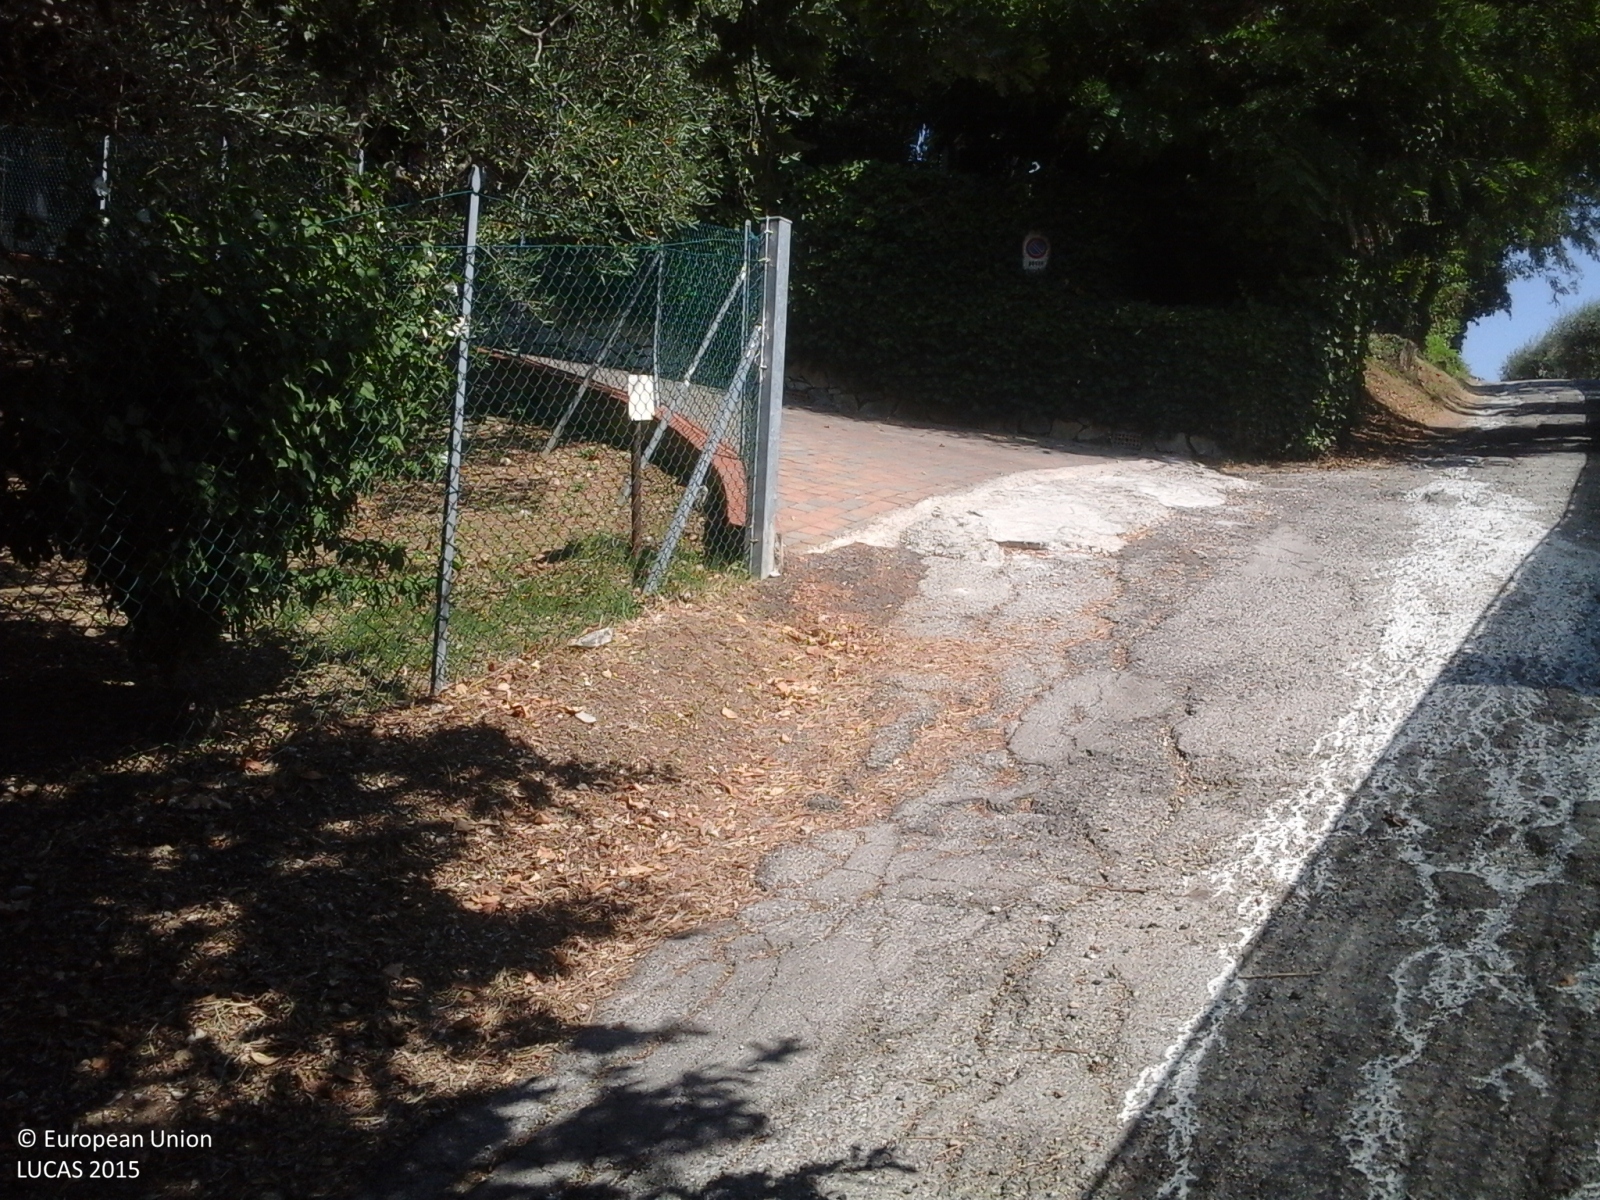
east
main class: Cropland
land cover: Olive groves
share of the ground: > 75 %
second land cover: Grassland without tree/shrub cover
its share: > 75 %
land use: Agriculture (excluding fallow land and kitchen gardens)
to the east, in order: Olive groves; Grassland without tree/shrub cover; Artificial constructions in urban areas; Olive groves; Electric lines; Olive groves; Artificial constructions in urban areas; Other fruit trees and berries; Common wheat; Electric lines; Common wheat; Electric lines; Grass margins; Ditches and canals; Grass margins; Paved roads, cycling and walking lanes; Common wheat; Artificial constructions in urban areas
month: July
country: IT
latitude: 44.0148
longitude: 12.4517
